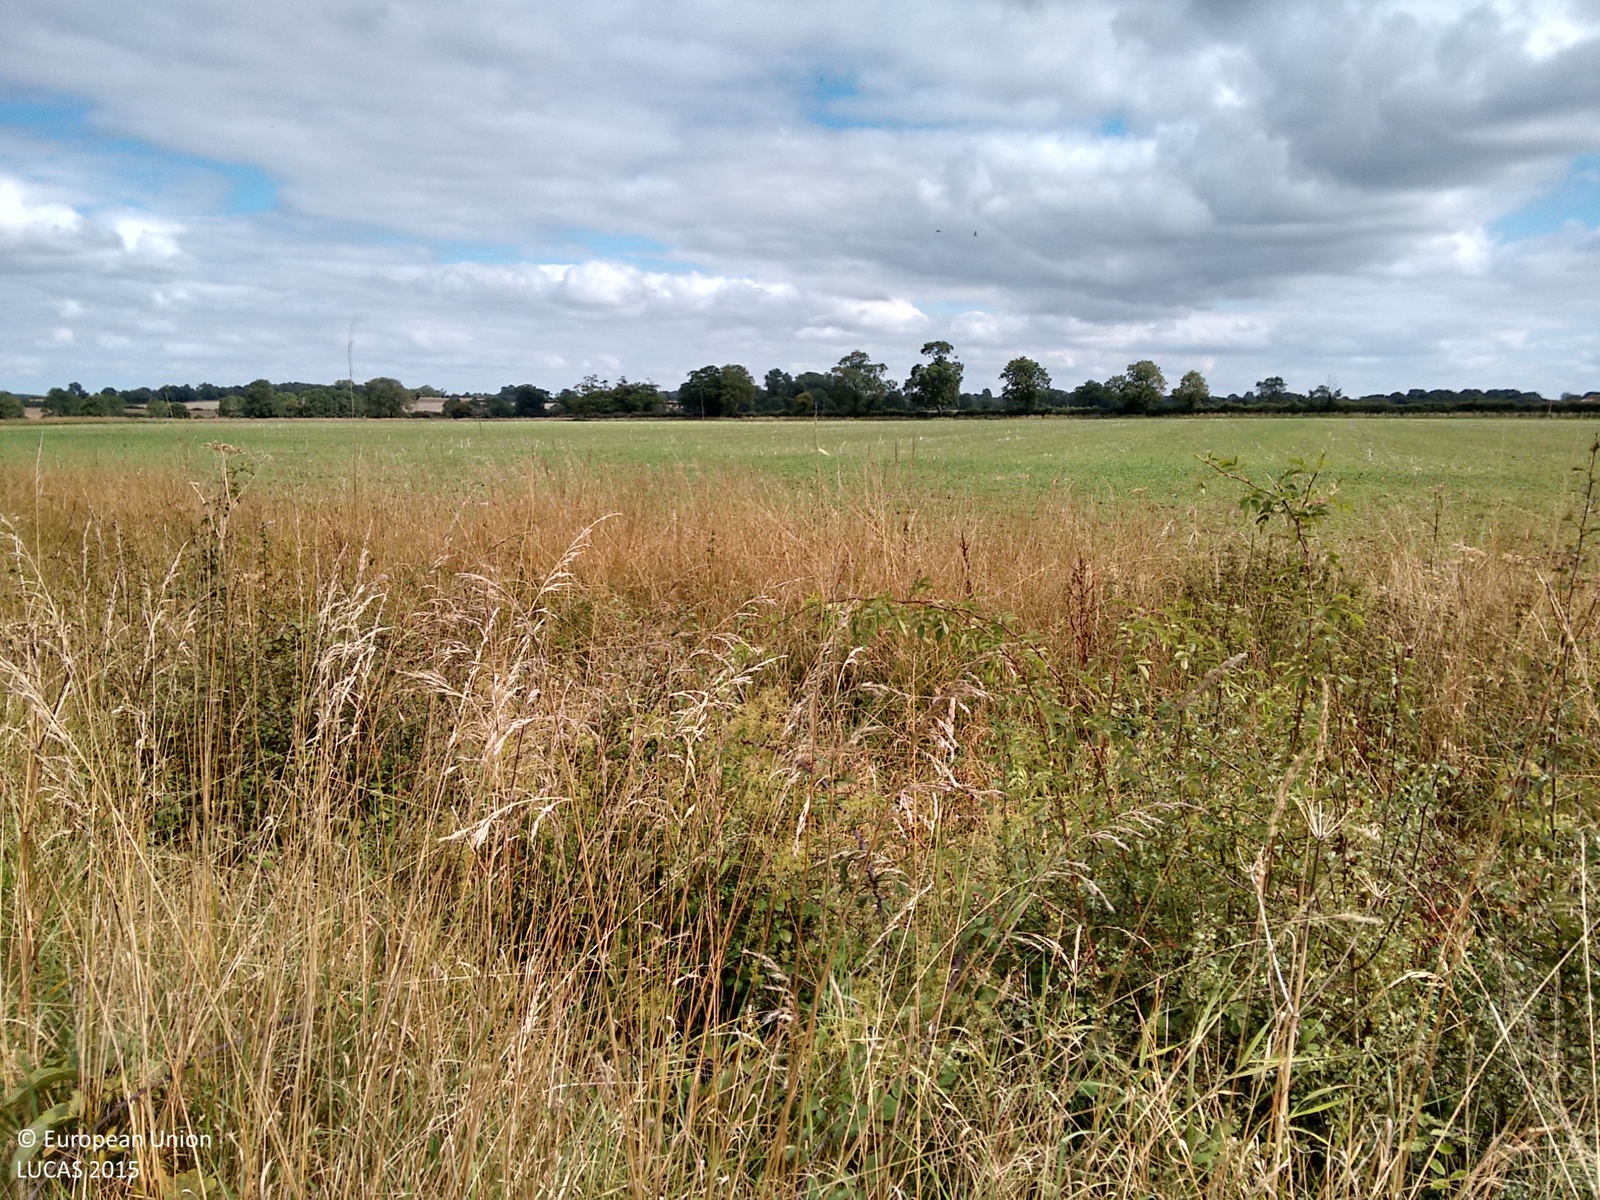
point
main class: Cropland
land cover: Common wheat
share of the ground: > 75 %
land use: Agriculture (excluding fallow land and kitchen gardens)
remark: Harvested field
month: September
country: GB
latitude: 52.6170
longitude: 0.8031
